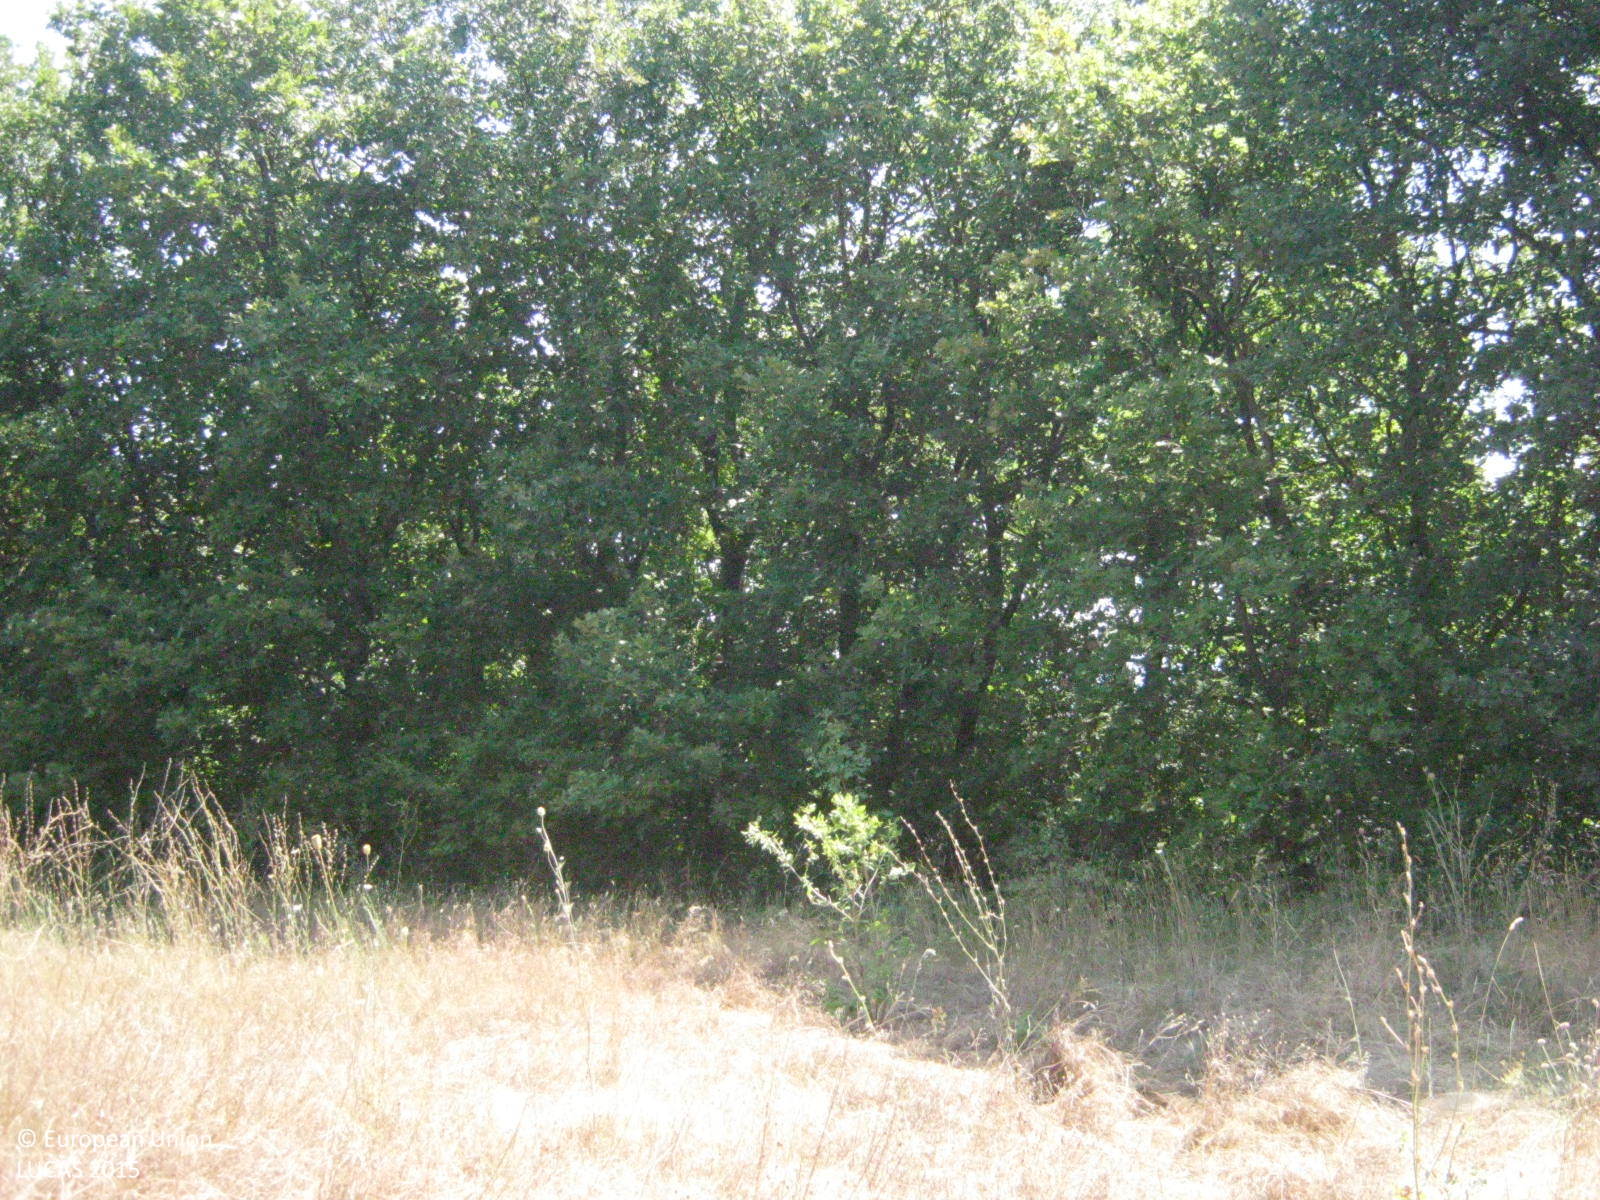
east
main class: Grassland
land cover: Spontaneously vegetated surfaces
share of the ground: > 75 %
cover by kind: herbaceous plants 100 %
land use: Fallow land
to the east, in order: Spontaneously vegetated surfaces; Broadleaved woodland; Rivers and streams; Broadleaved woodland; Grass margins; Tracks; Common wheat; Cotton
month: August
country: GR
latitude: 41.1741
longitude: 22.8499
